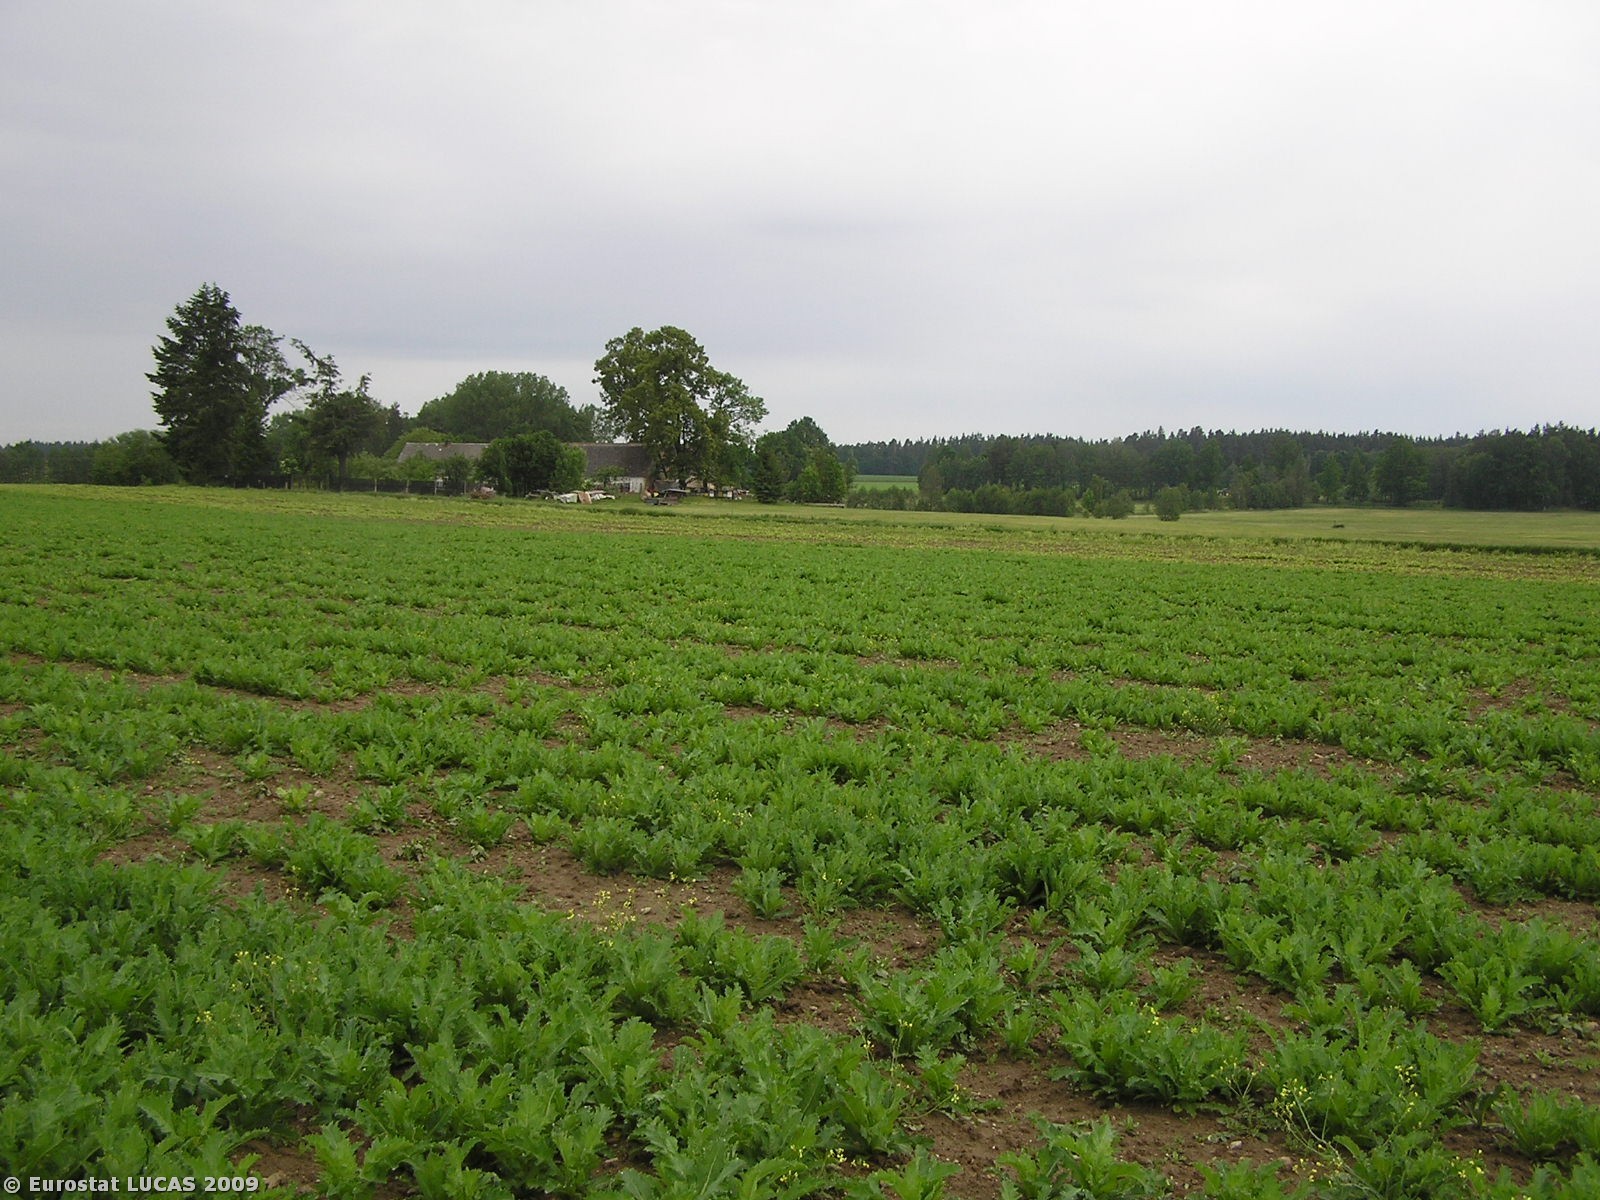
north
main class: Cropland
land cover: Other fibre and oleaginous crops
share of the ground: 50 - 75 %
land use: Agriculture (excluding fallow land and kitchen gardens)
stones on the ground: 10 - 25 %
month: May
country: CZ
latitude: 49.1960
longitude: 14.9011
